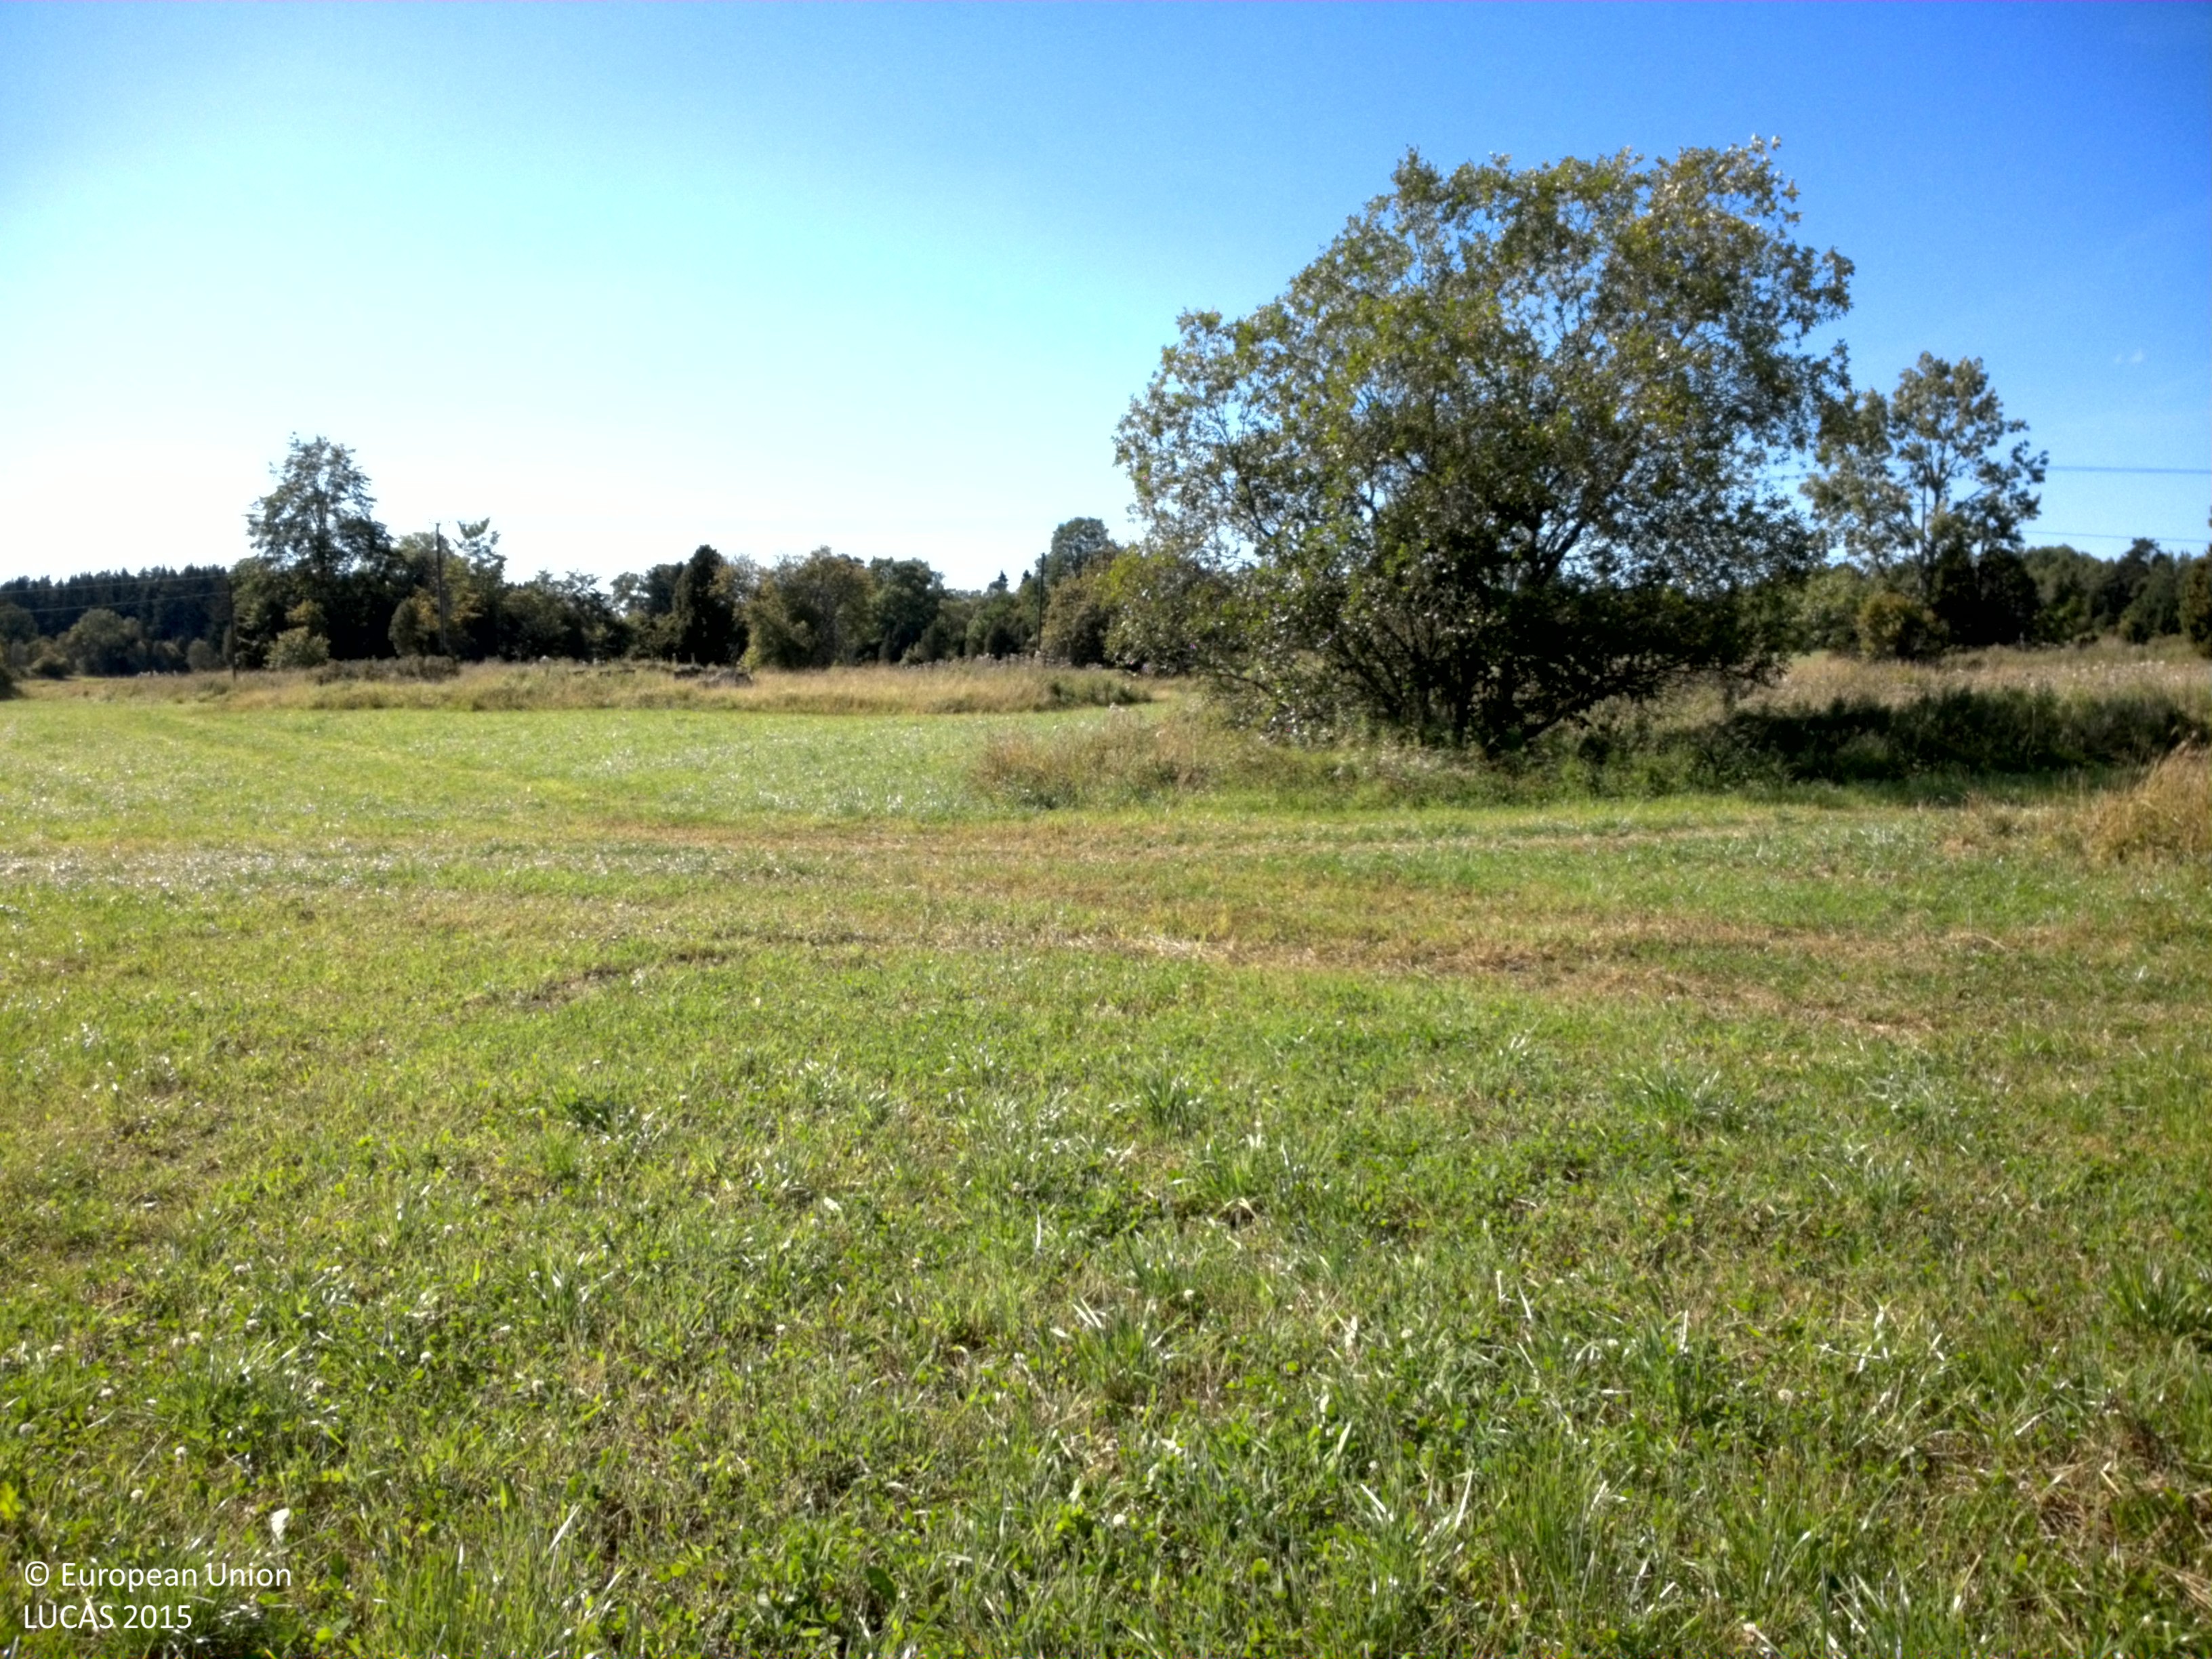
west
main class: Cropland
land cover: Other leguminous and mixtures for fodder
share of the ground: > 75 %
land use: Agriculture (excluding fallow land and kitchen gardens)
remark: Harvested field
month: August
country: SE
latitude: 59.9912
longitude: 17.9719
